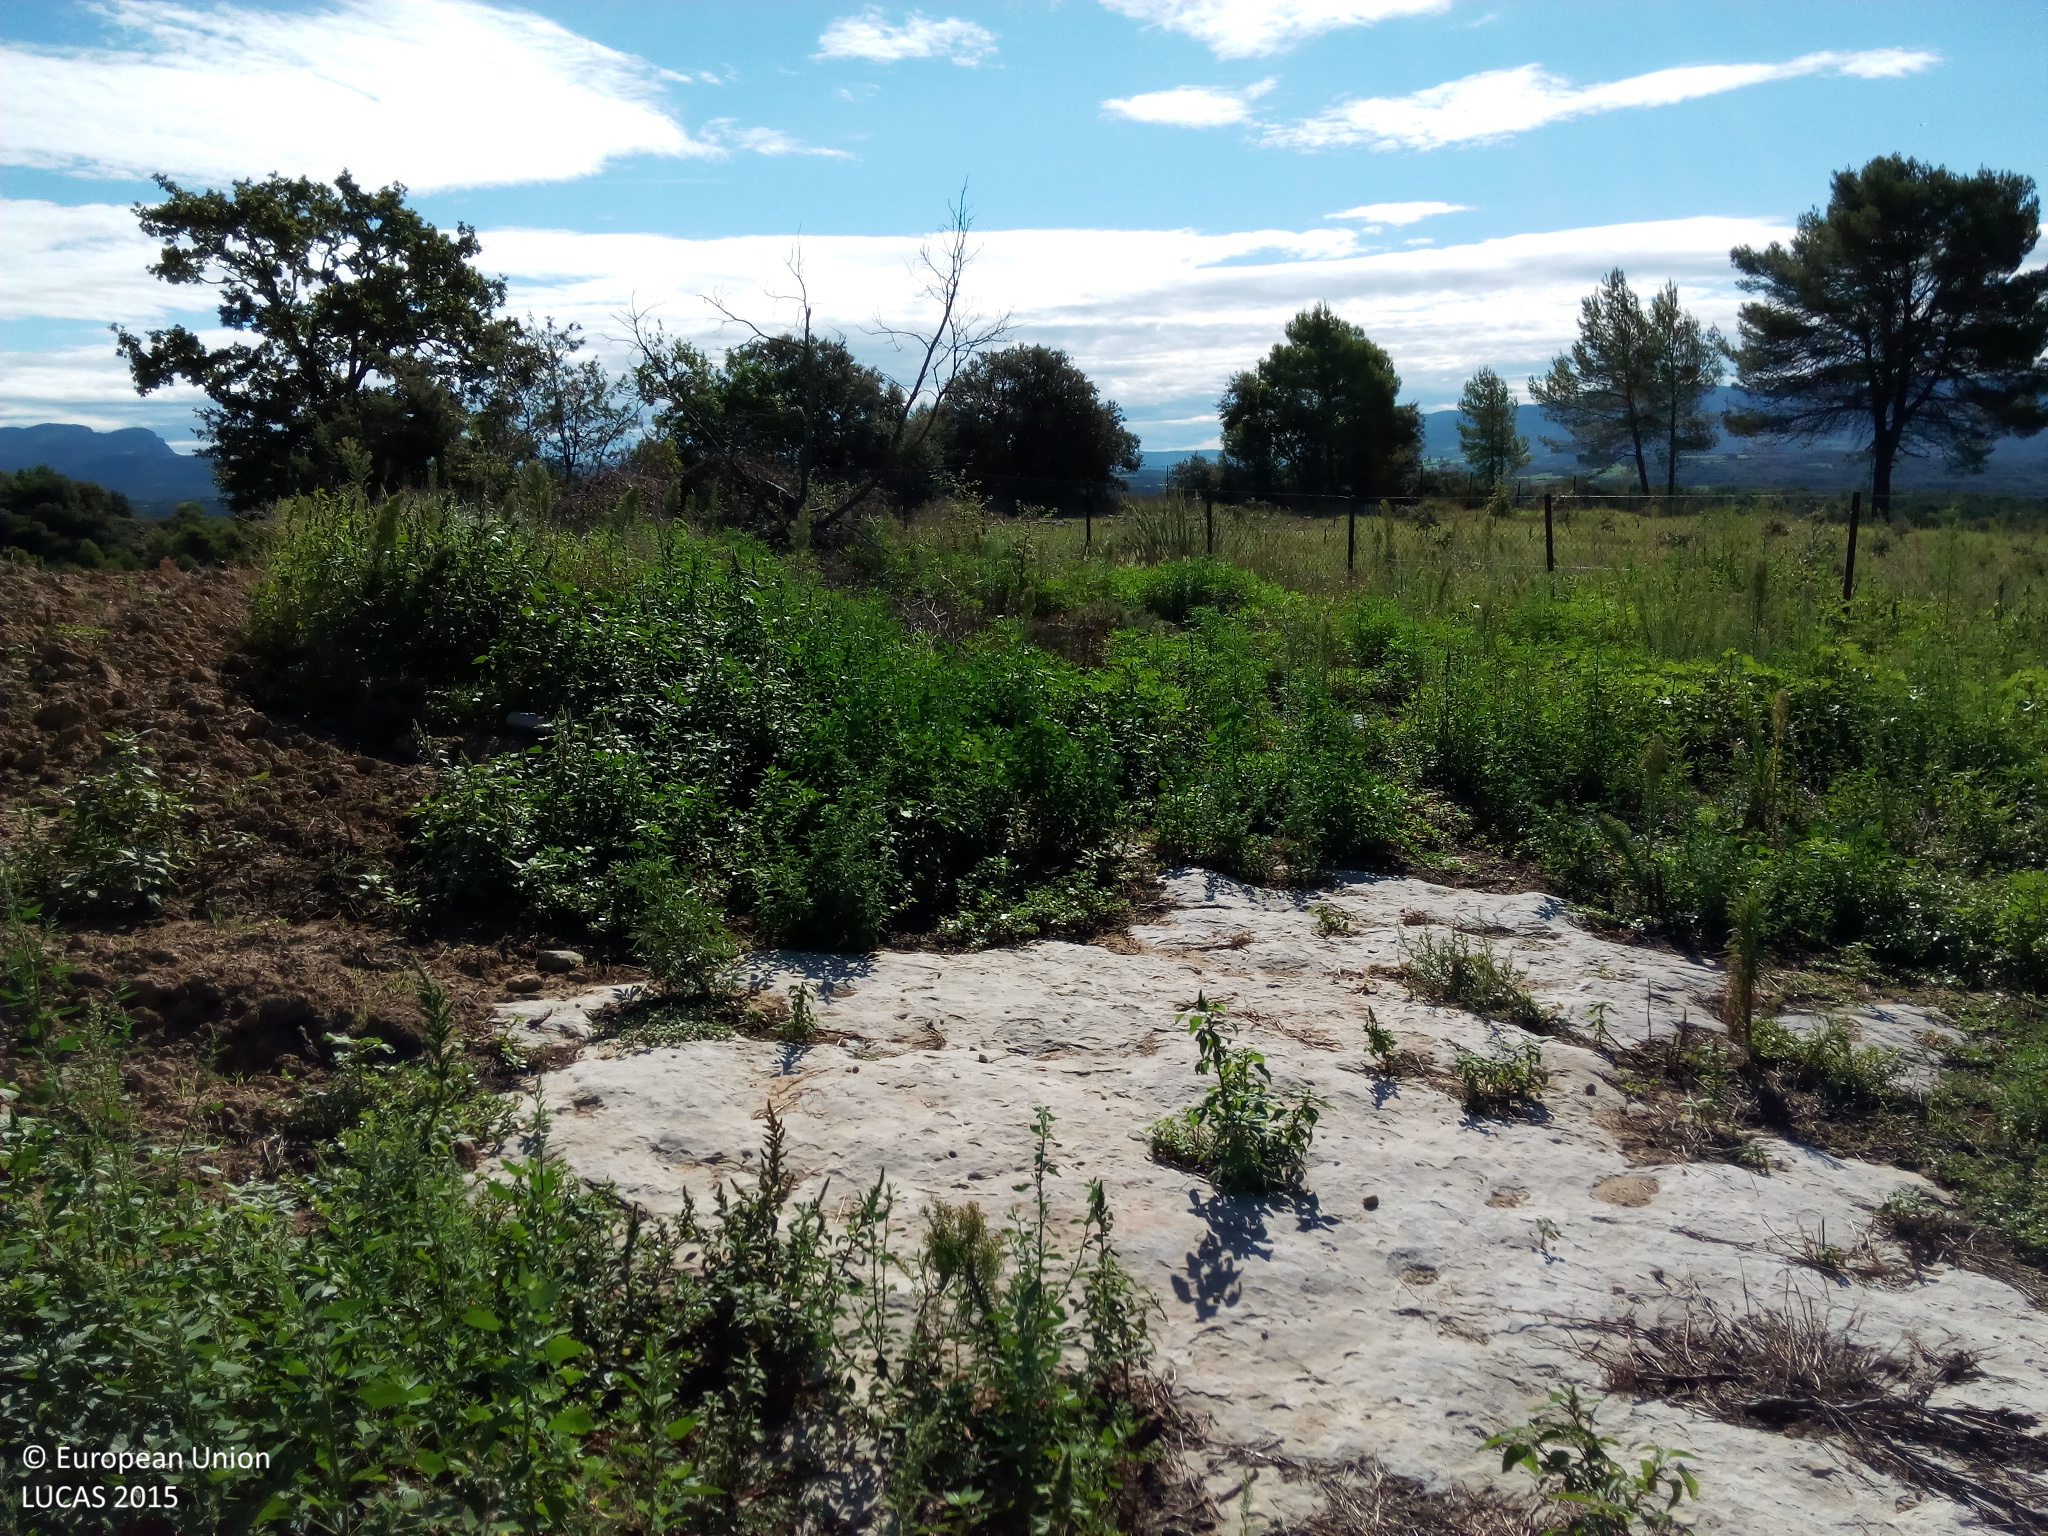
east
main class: Grassland
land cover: Grassland without tree/shrub cover
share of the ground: > 75 %
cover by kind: herbaceous plants 100 %
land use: Semi-natural and natural areas not in use
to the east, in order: Grassland without tree/shrub cover; Electric lines; Grassland without tree/shrub cover; Single bushes/trees; Tracks; Spontaneously vegetated surfaces; Broadleaved woodland; Grassland without tree/shrub cover; Broadleaved woodland; Spontaneously vegetated surfaces; Broadleaved woodland
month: August
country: ES
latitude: 42.2441
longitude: 0.3222
